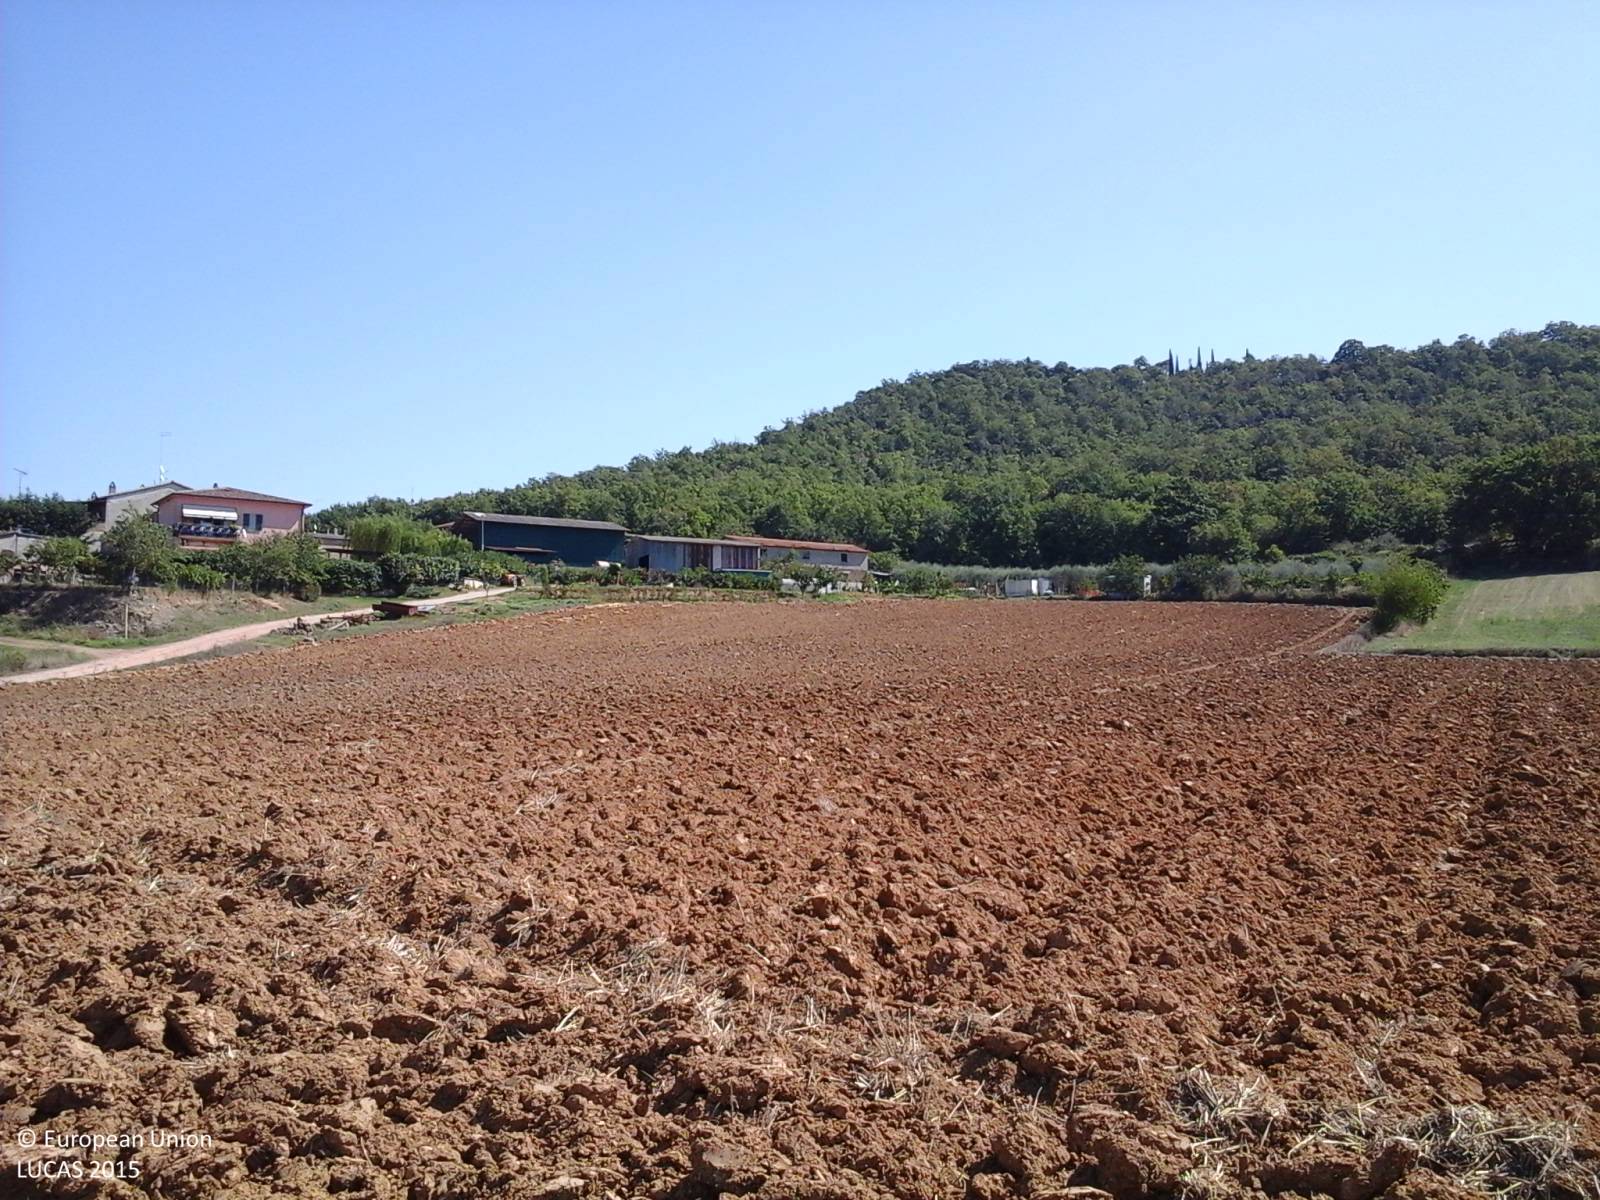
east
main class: Cropland
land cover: Durum wheat
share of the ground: < 10 %
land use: Agriculture (excluding fallow land and kitchen gardens)
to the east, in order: Durum wheat; Ditches and canals; Other fruit trees and berries; Artificial constructions in urban areas
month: September
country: IT
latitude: 43.0803
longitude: 12.2657
